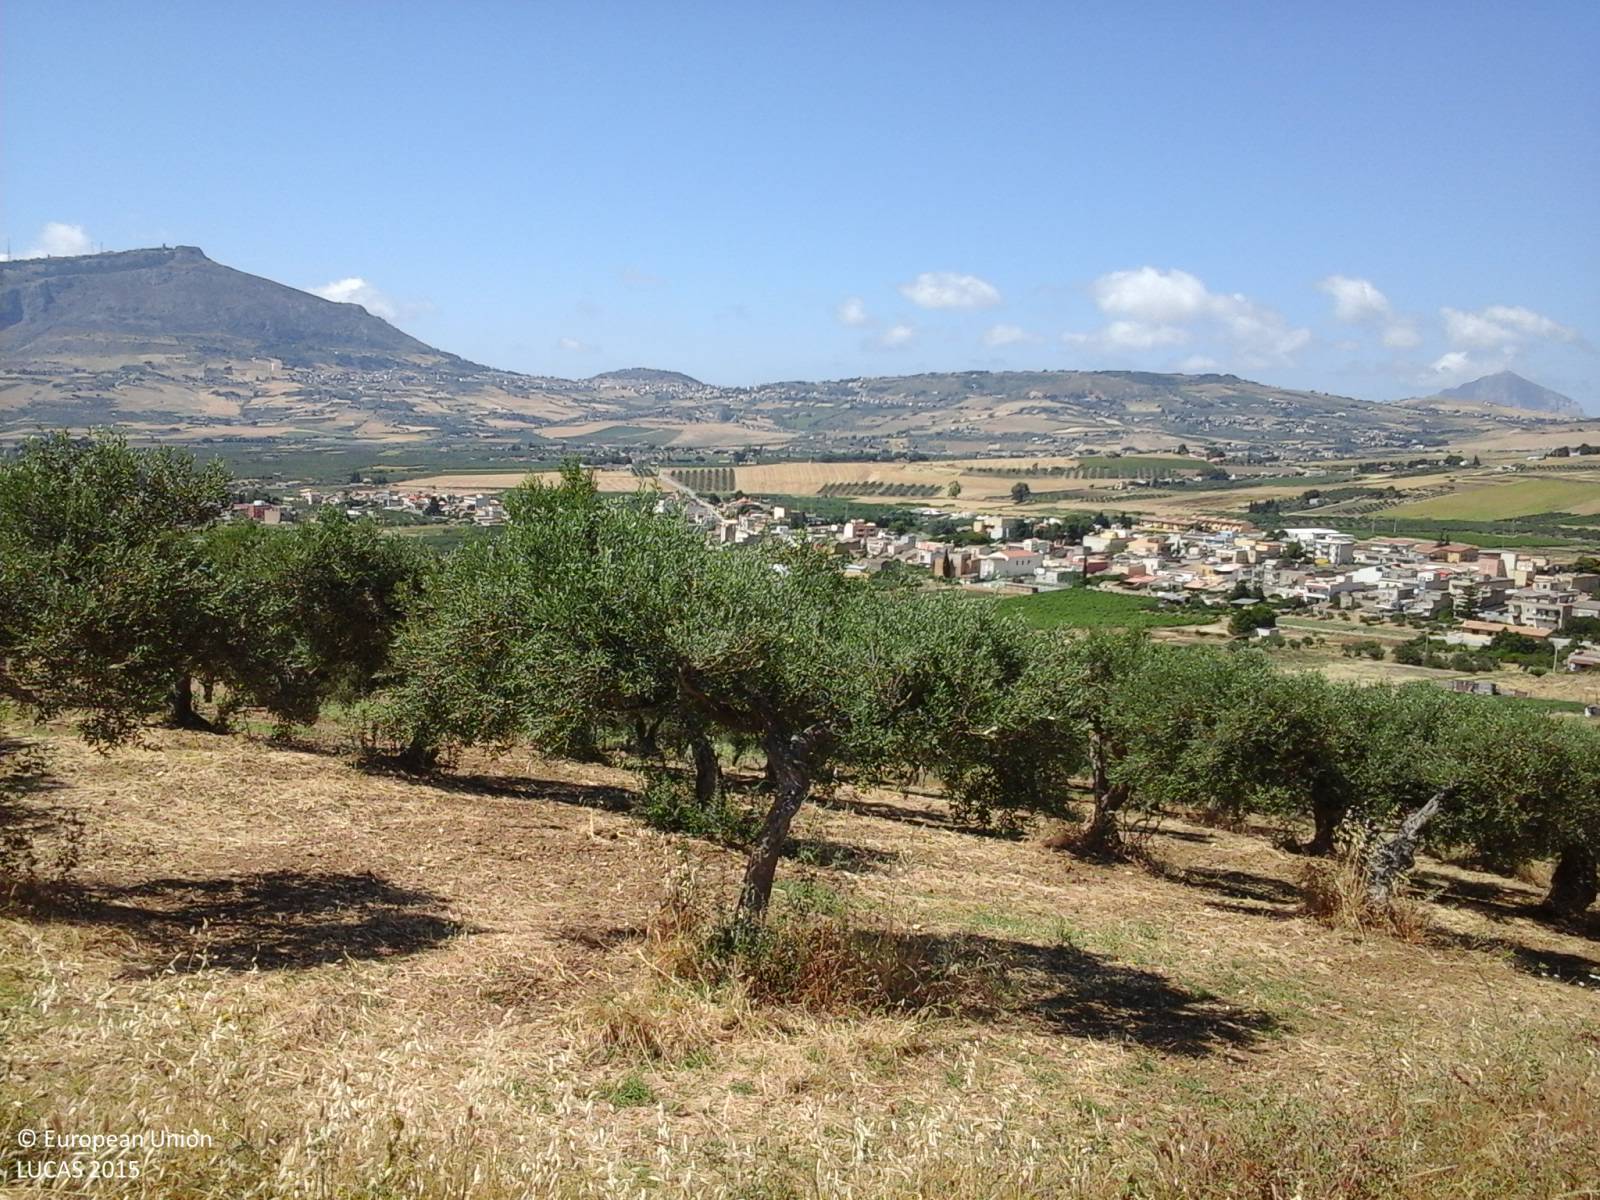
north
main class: Cropland
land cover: Durum wheat
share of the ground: > 75 %
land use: Agriculture (excluding fallow land and kitchen gardens)
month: June
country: IT
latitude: 37.9835
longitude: 12.6337
